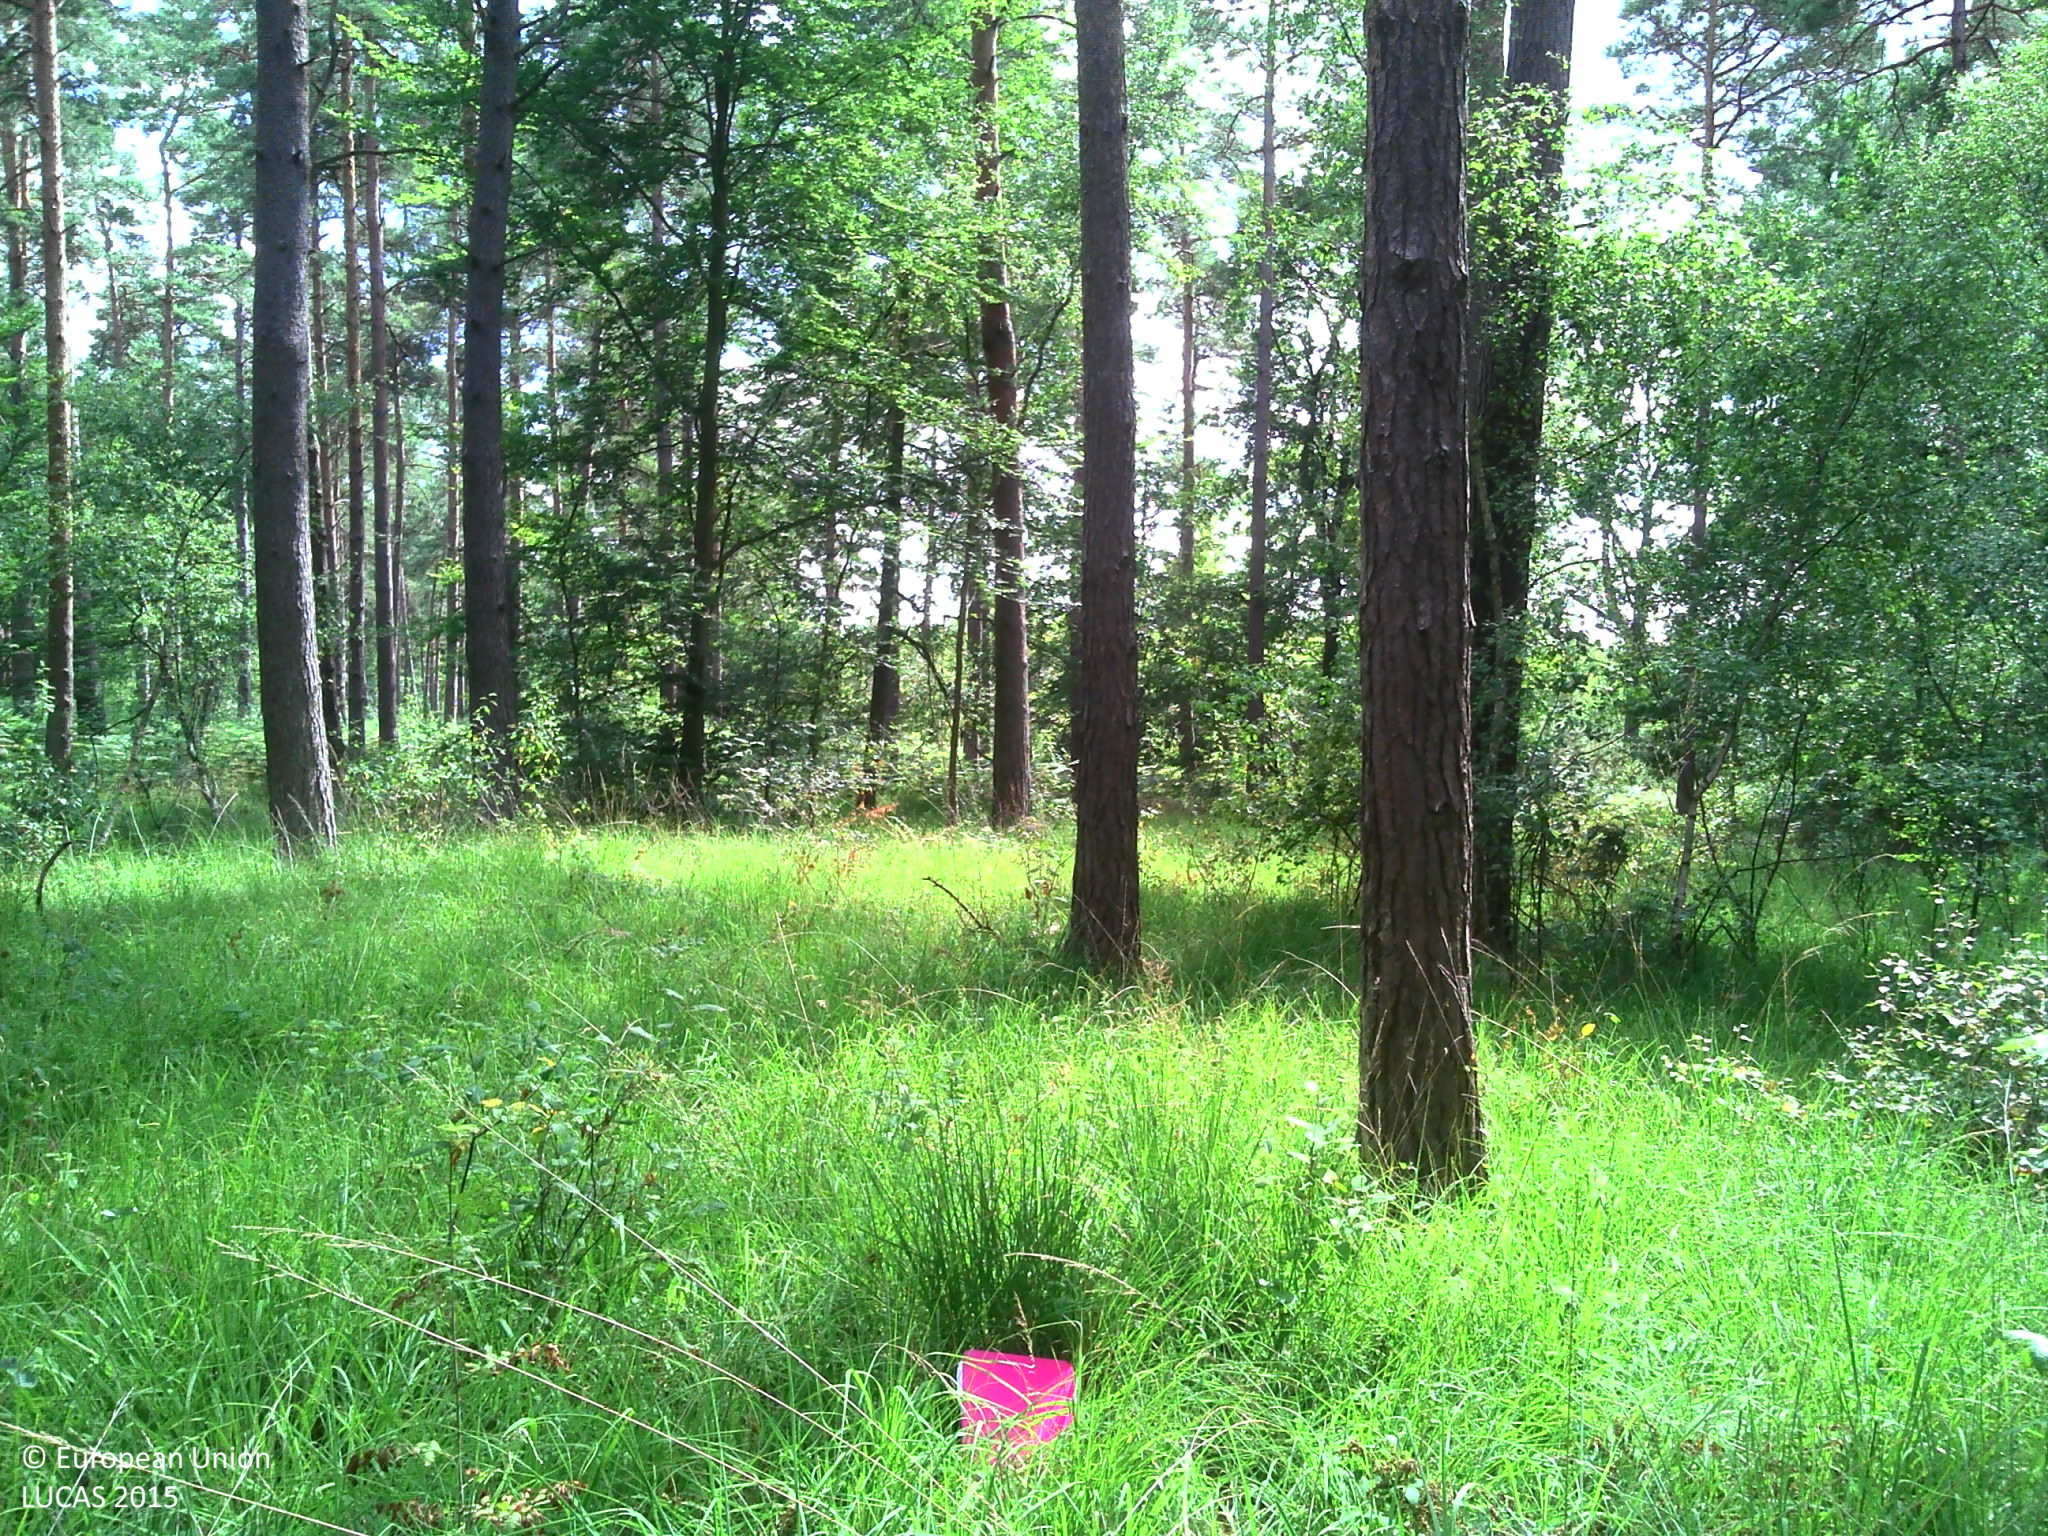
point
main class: Woodland
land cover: Pine dominated mixed woodland
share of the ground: > 75 %
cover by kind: coniferous forest trees 40 %, broadleaved forest trees 30 %, herbaceous plants 20 %, shrubs 10 %
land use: Forestry
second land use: Amenities, museums, leisure
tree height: > 5 m
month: July
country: FR
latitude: 49.1346
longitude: 2.6566
